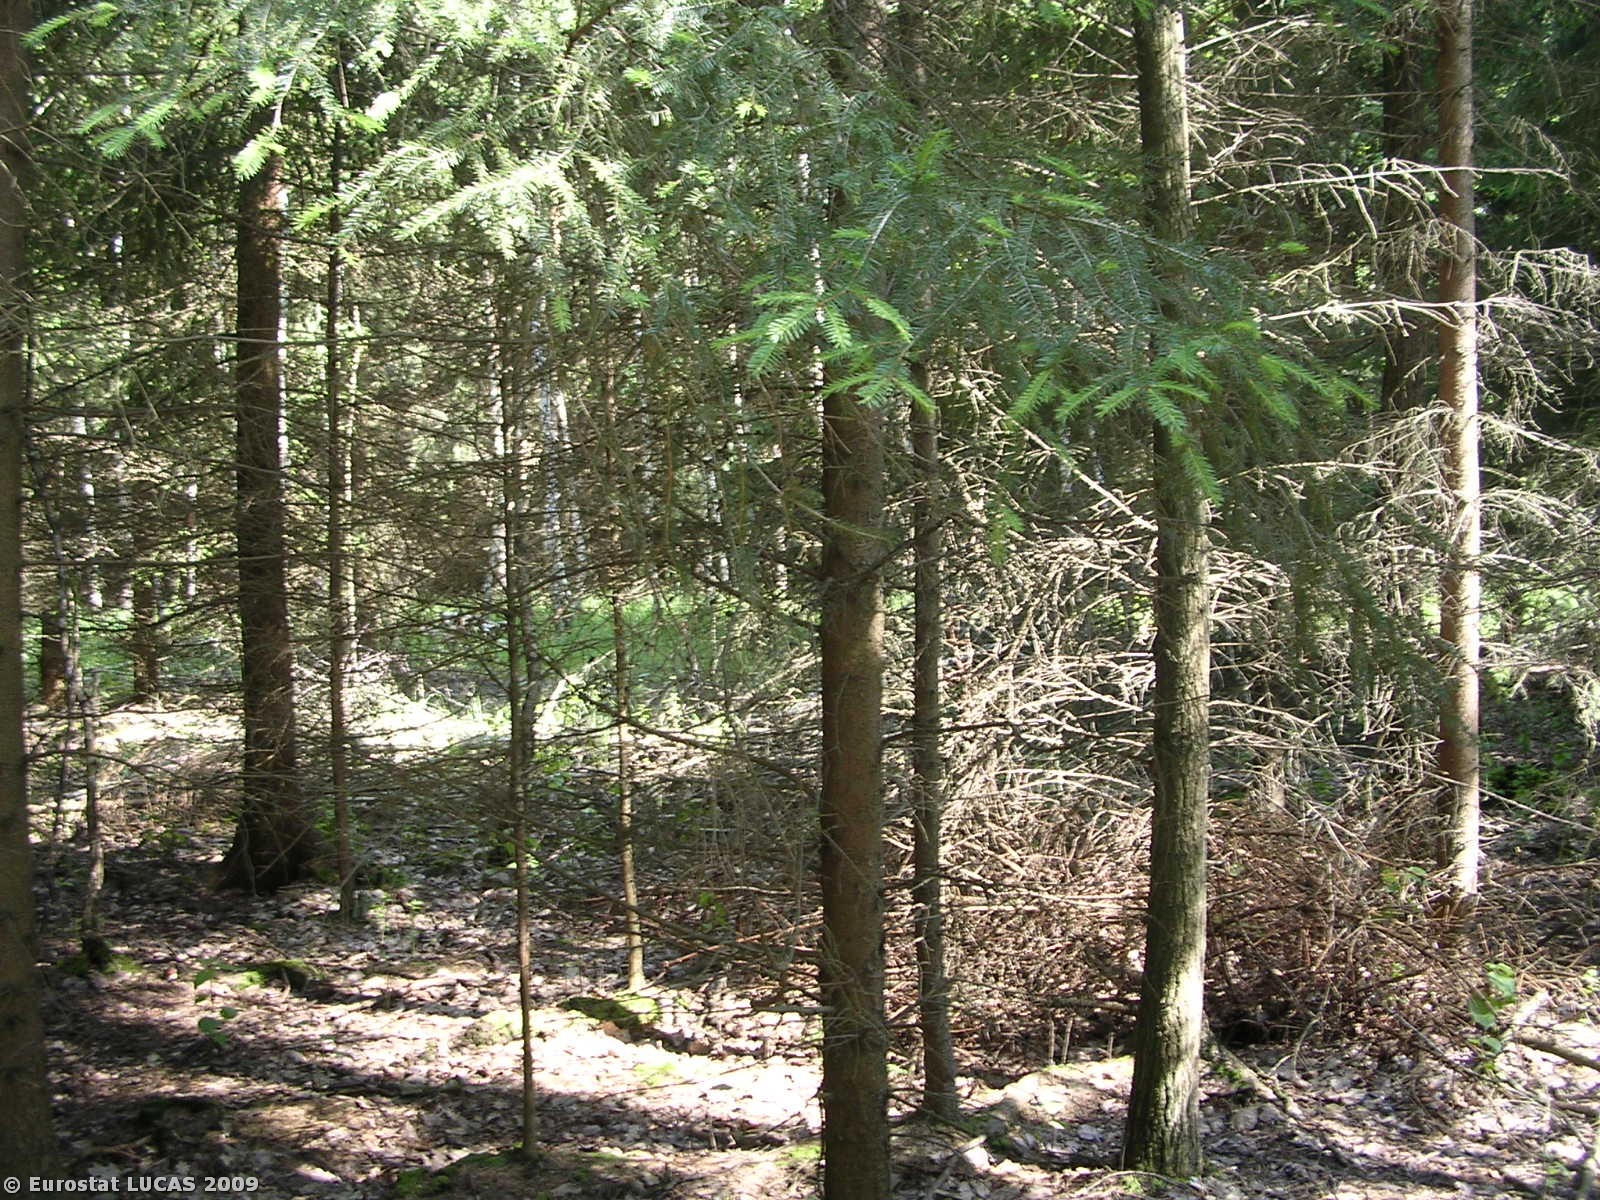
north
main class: Woodland
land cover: Coniferous woodland
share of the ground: > 75 %
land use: Forestry
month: June
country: CZ
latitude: 50.4516
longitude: 15.0309
